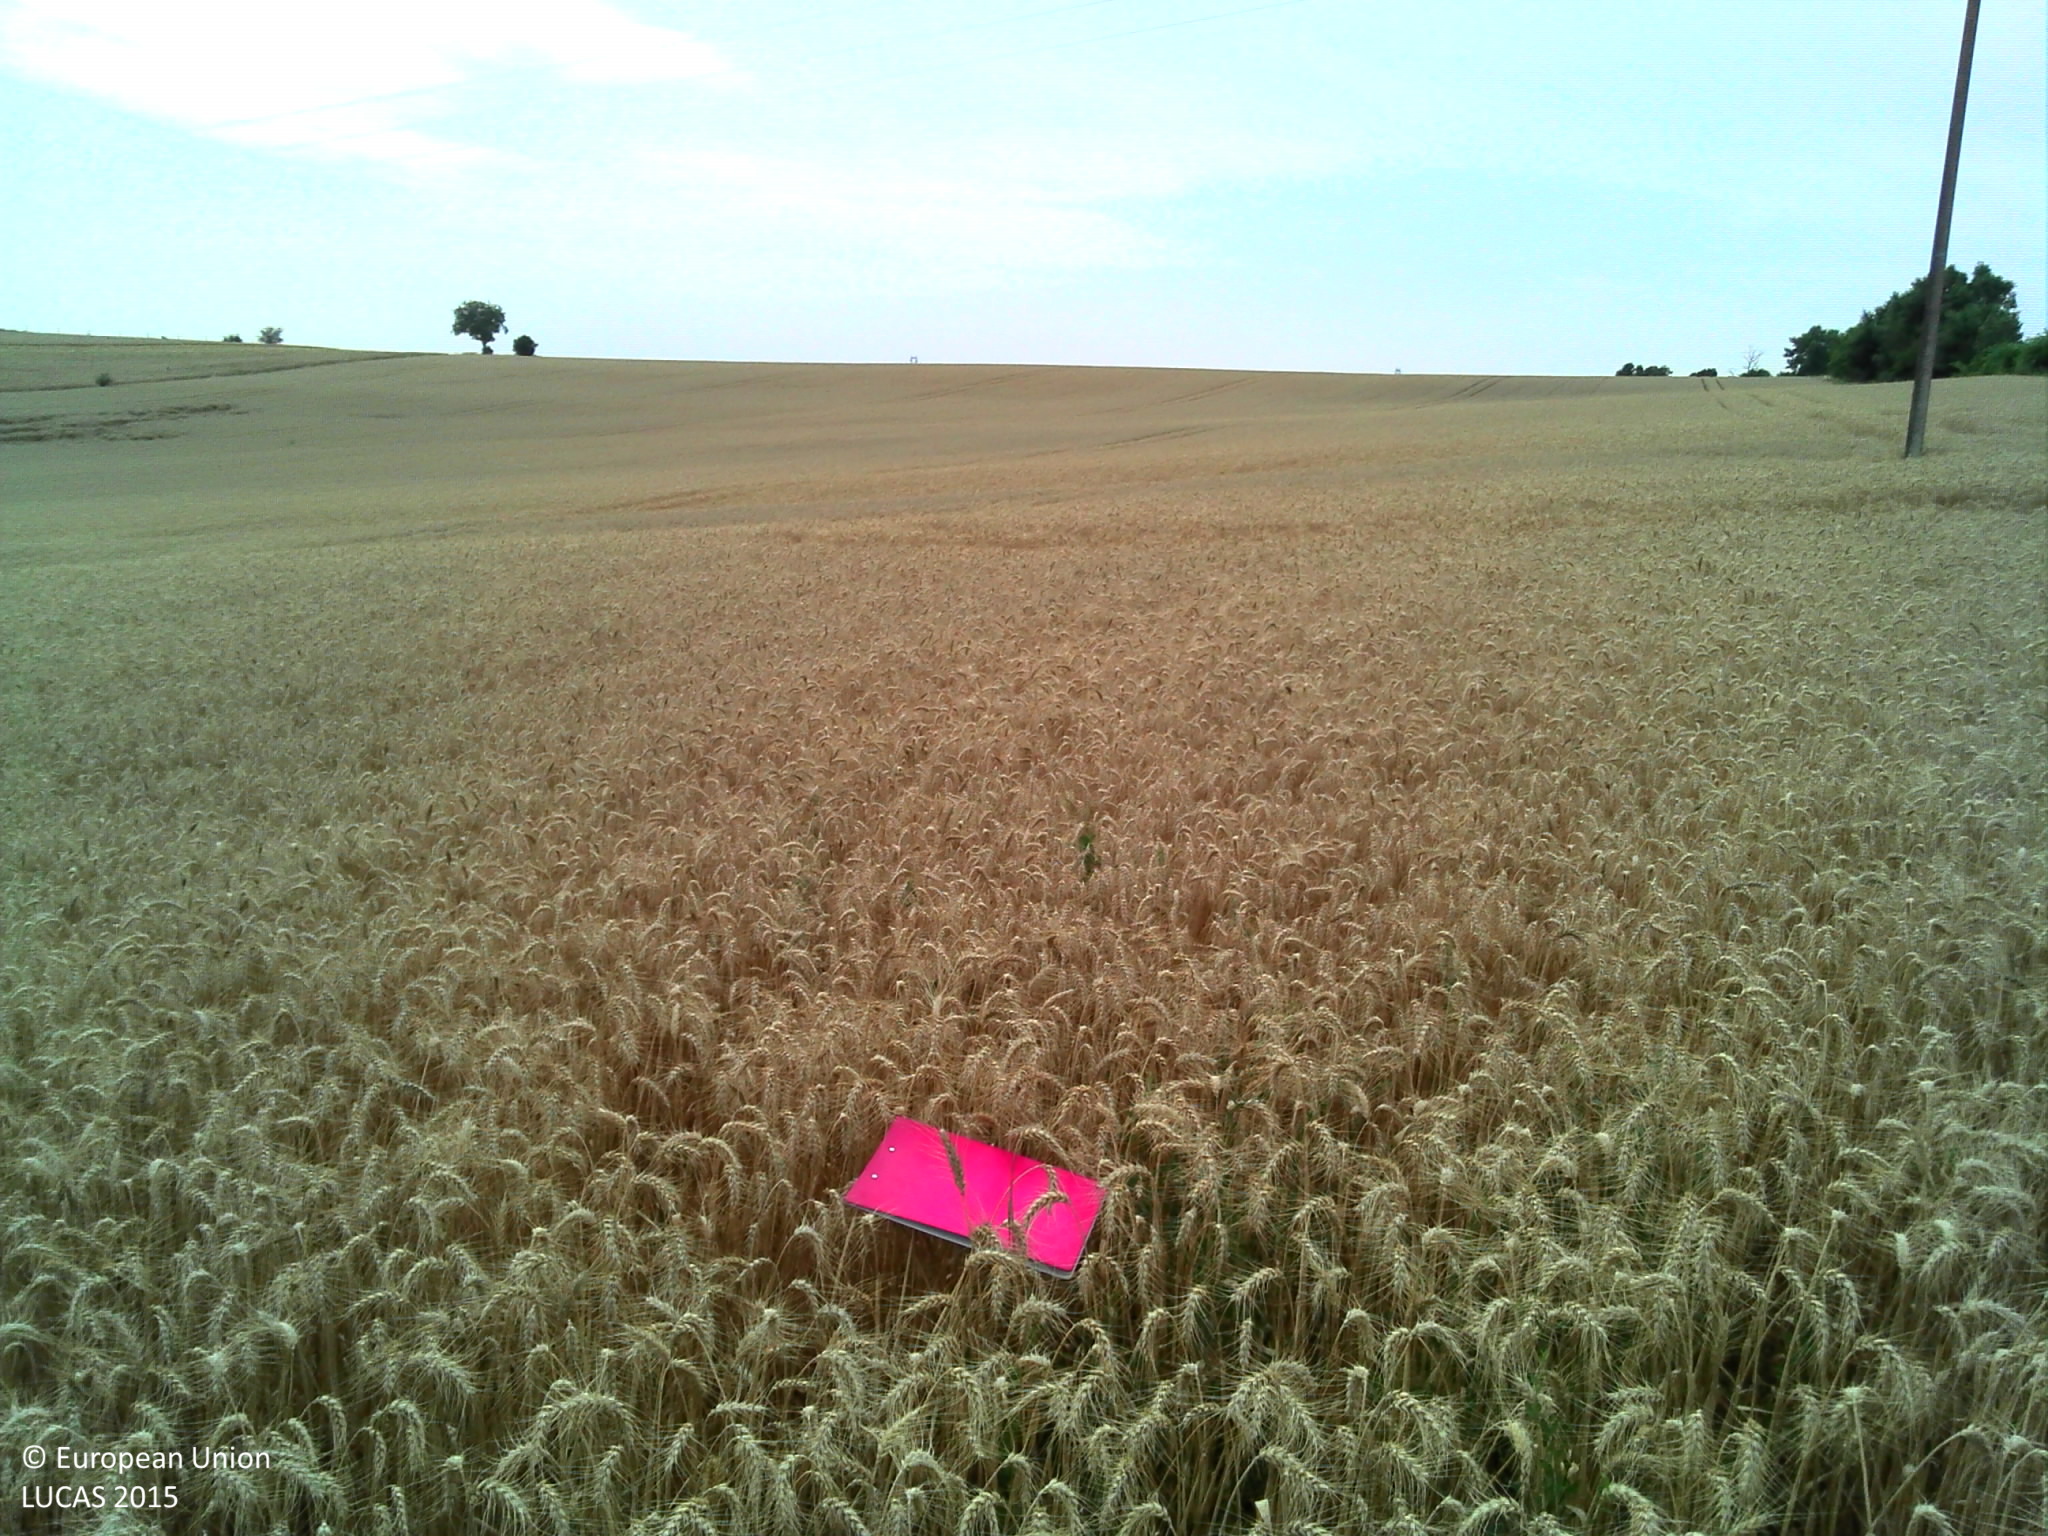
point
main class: Cropland
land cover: Durum wheat
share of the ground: > 75 %
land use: Agriculture (excluding fallow land and kitchen gardens)
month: July
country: FR
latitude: 43.5977
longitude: 1.0196
